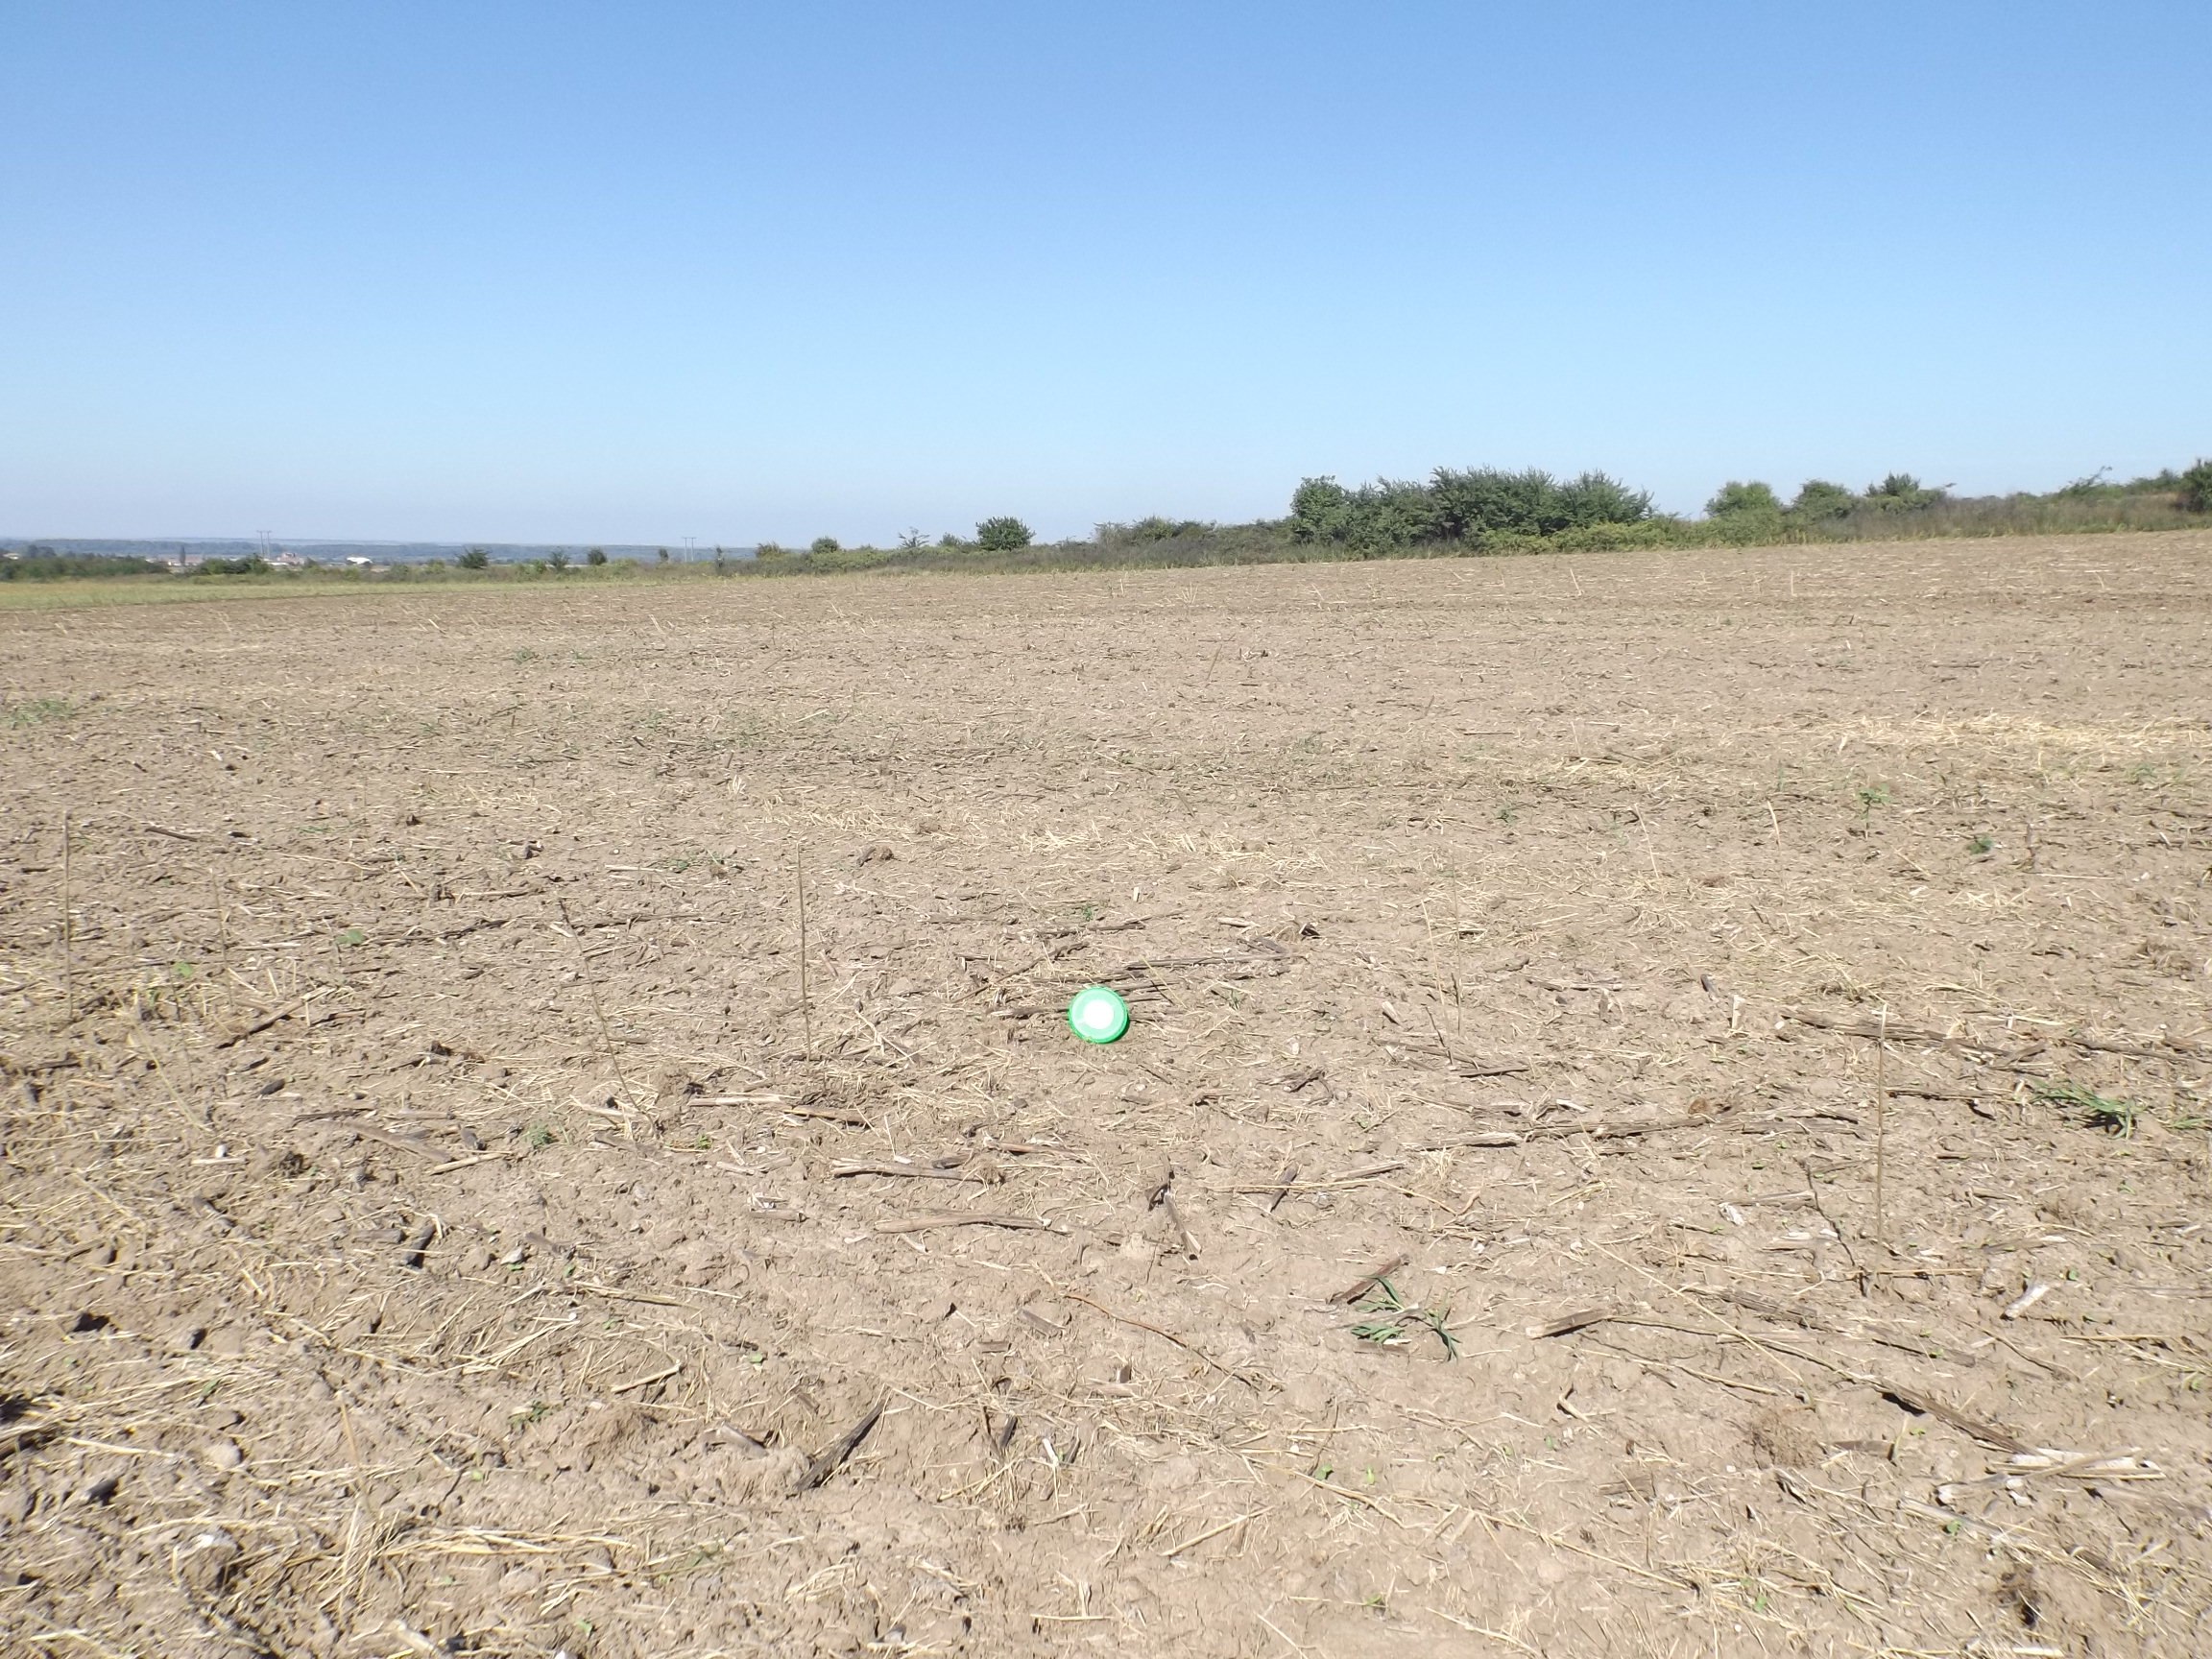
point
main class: Cropland
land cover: Sunflower
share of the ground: < 10 %
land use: Agriculture (excluding fallow land and kitchen gardens)
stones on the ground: < 10 %
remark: Harvested field
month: September
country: BG
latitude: 43.9916
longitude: 26.5073
